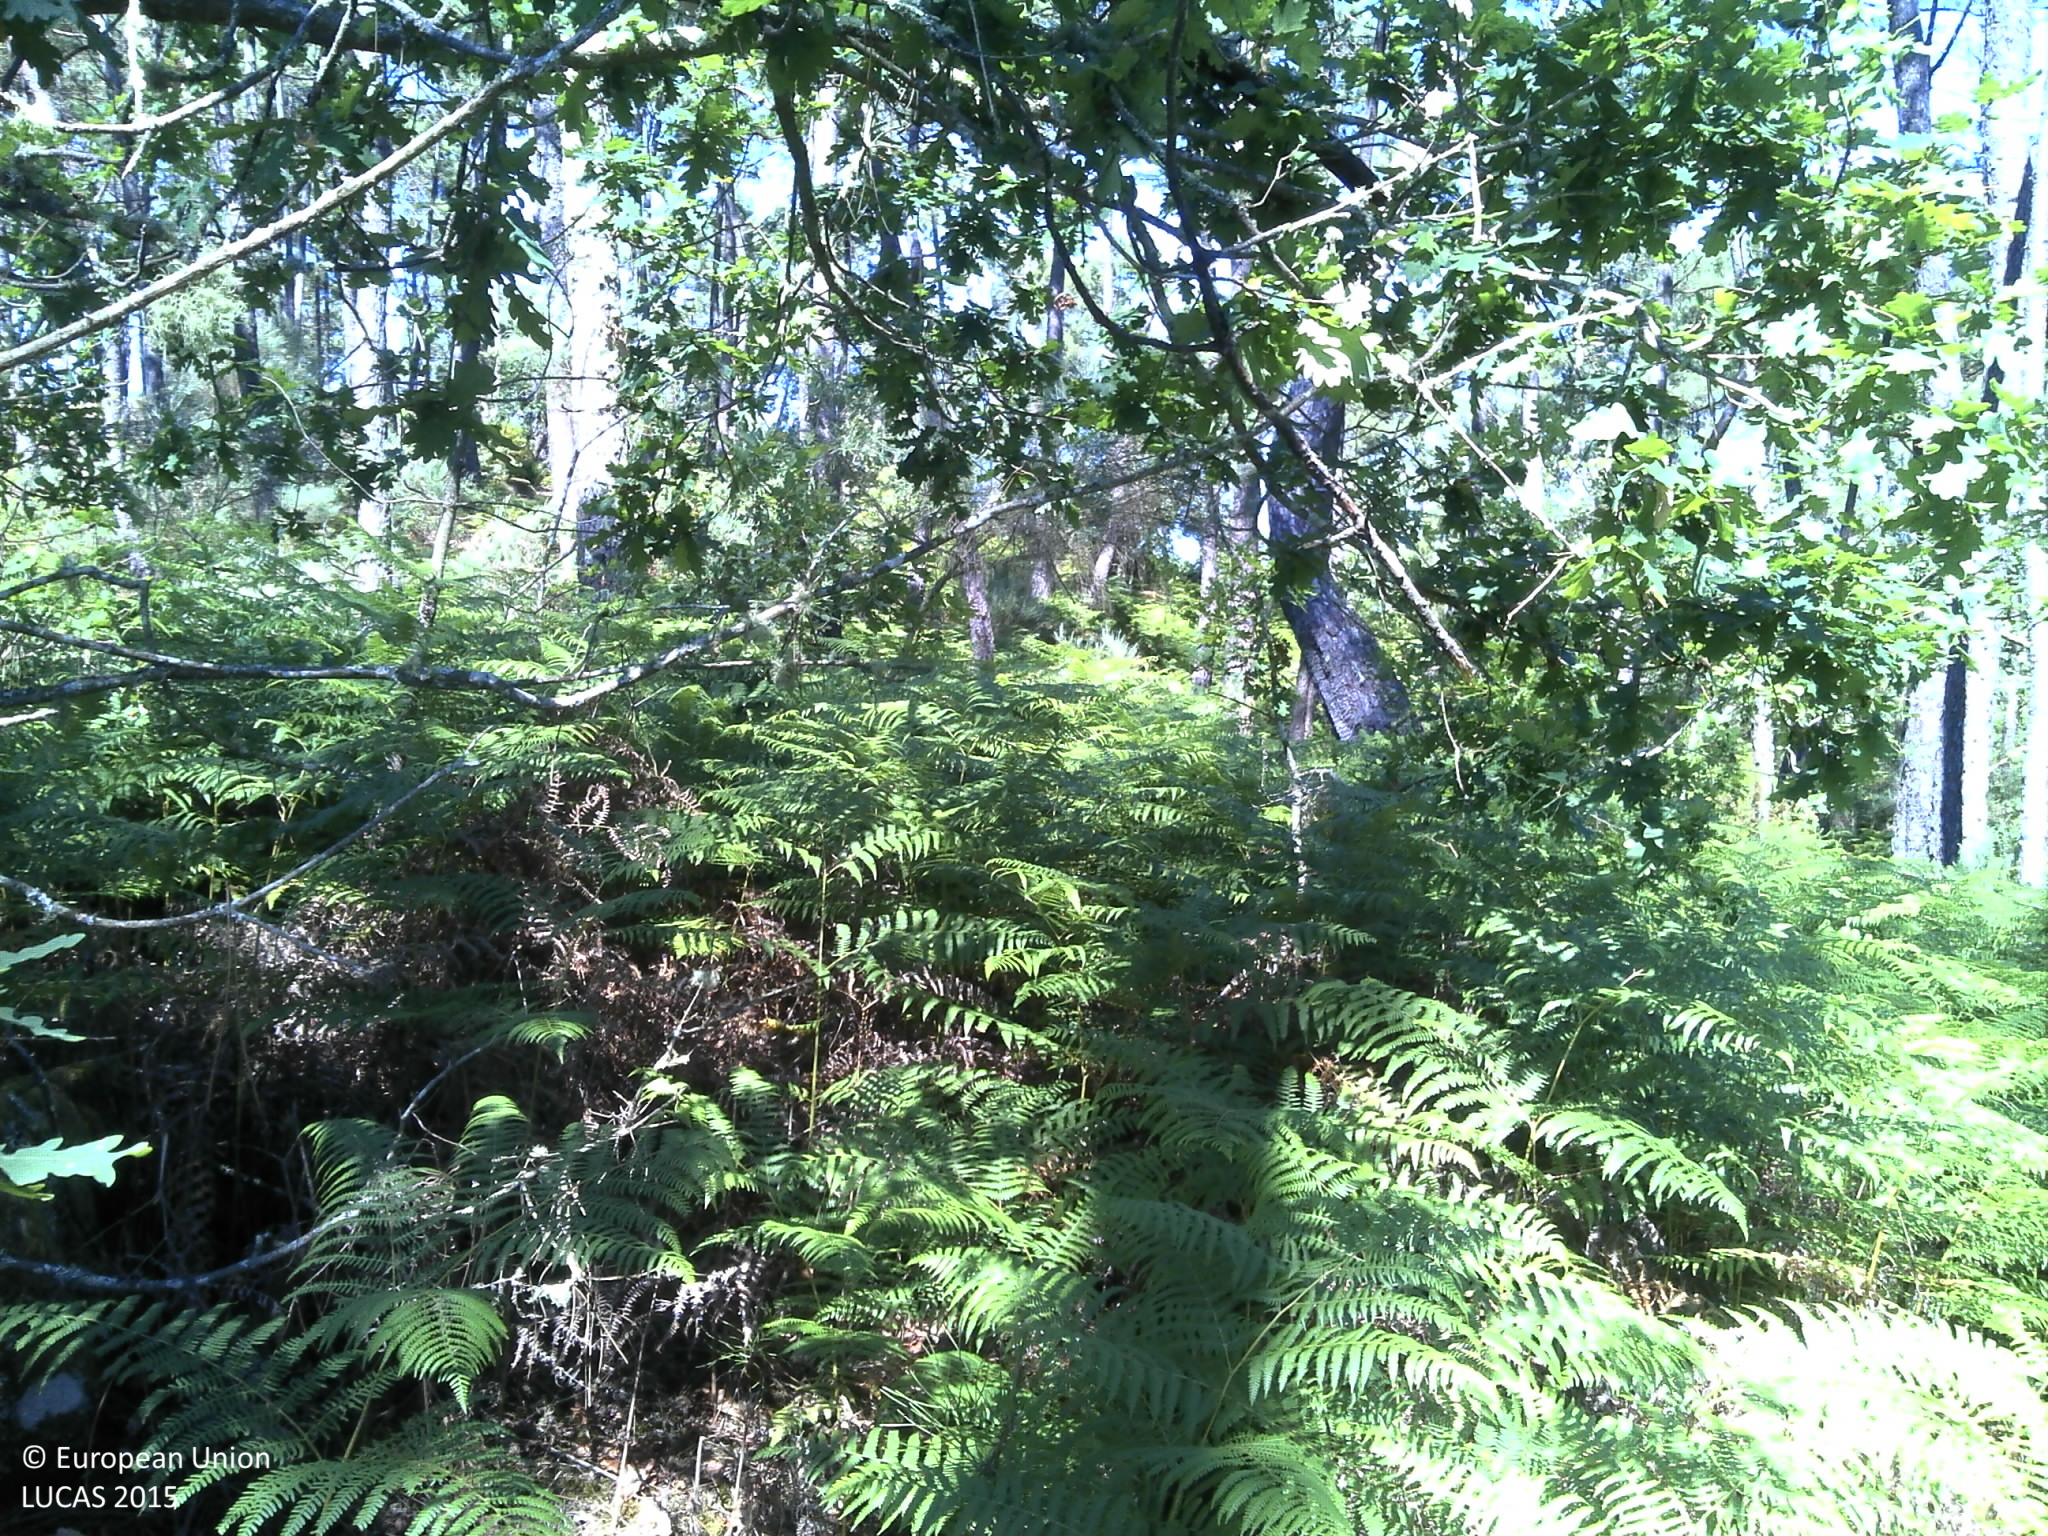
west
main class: Woodland
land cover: Pine dominated coniferous woodland
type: coniferous forest of the mediterranean region
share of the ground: > 75 %
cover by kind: coniferous forest trees 75 %, shrubs 15 %, unconsolidated bare surface 10 %
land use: Forestry
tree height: > 5 m
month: June
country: PT
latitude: 40.6875
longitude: -8.0311
